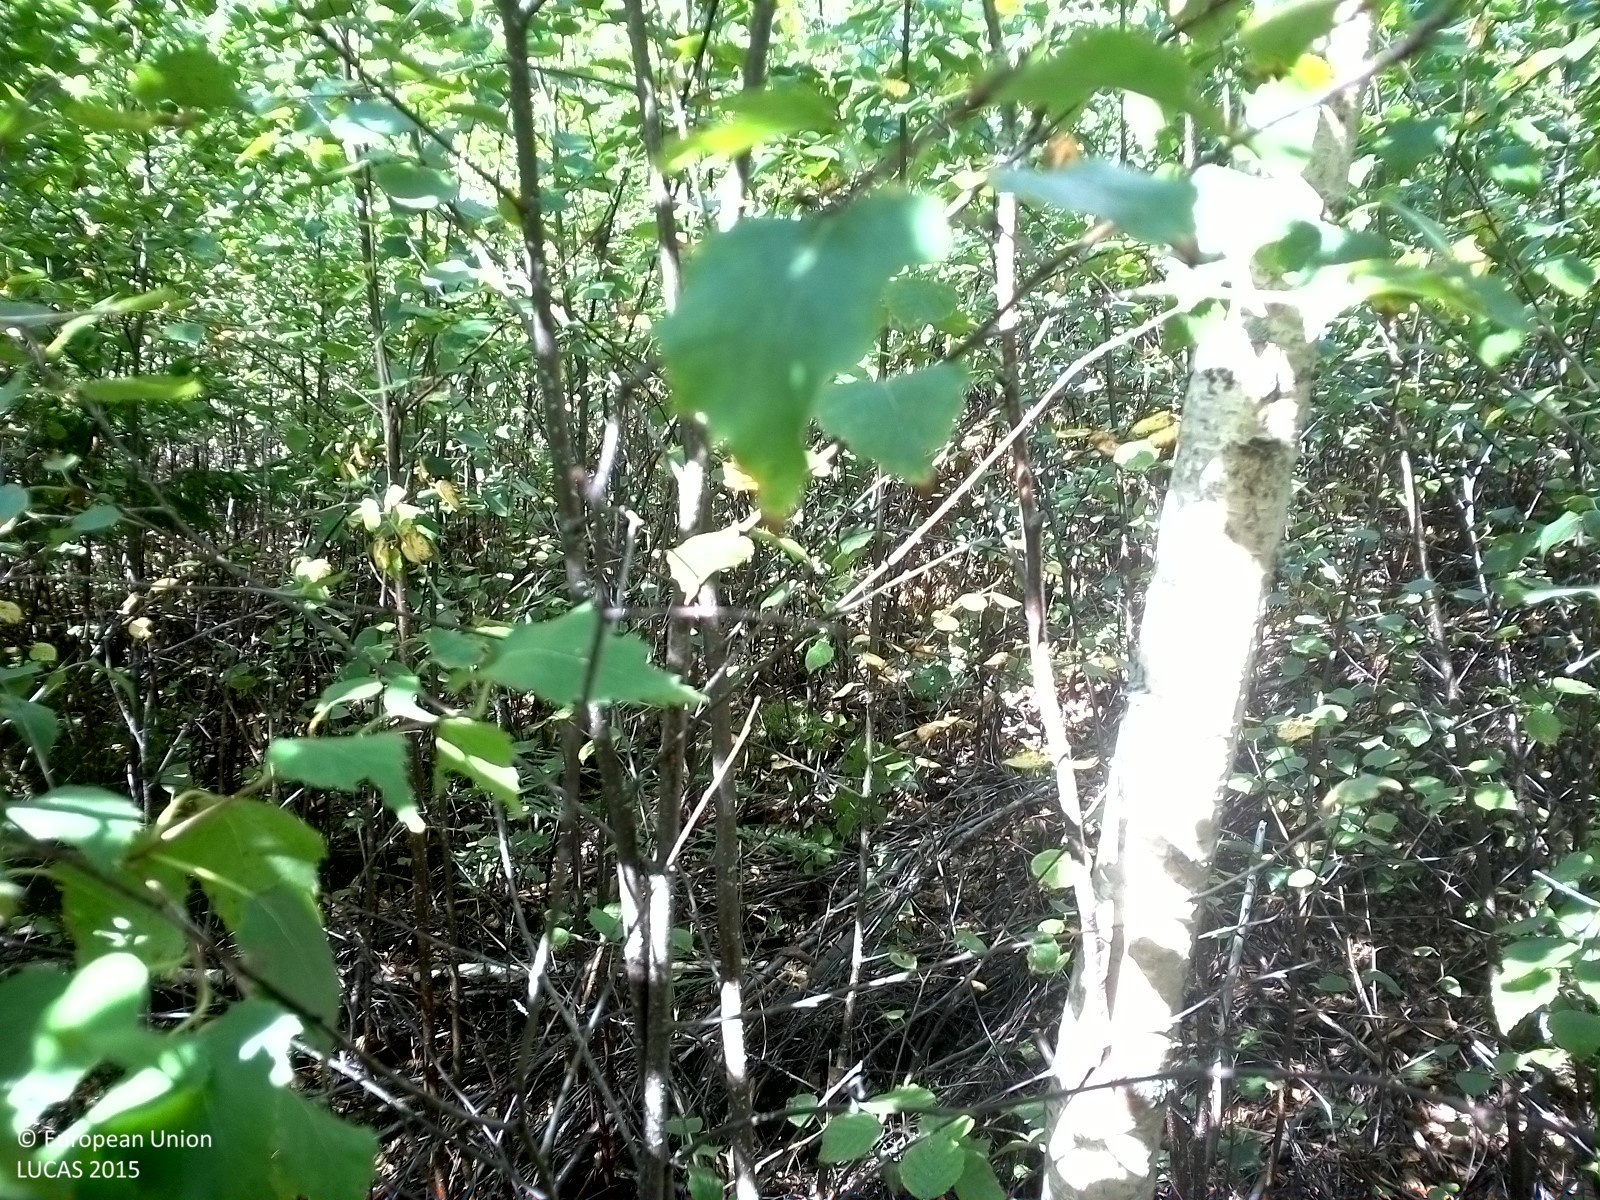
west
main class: Woodland
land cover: Broadleaved woodland
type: hemiboreal forest and nemoral coniferous forest and mixed broadleaved-coniferous forest
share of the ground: > 75 %
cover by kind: broadleaved forest trees 90 %, herbaceous plants 5 %, unconsolidated bare surface 5 %
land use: Forestry
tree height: < 5 m
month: August
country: SE
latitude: 59.2469
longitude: 15.4096
